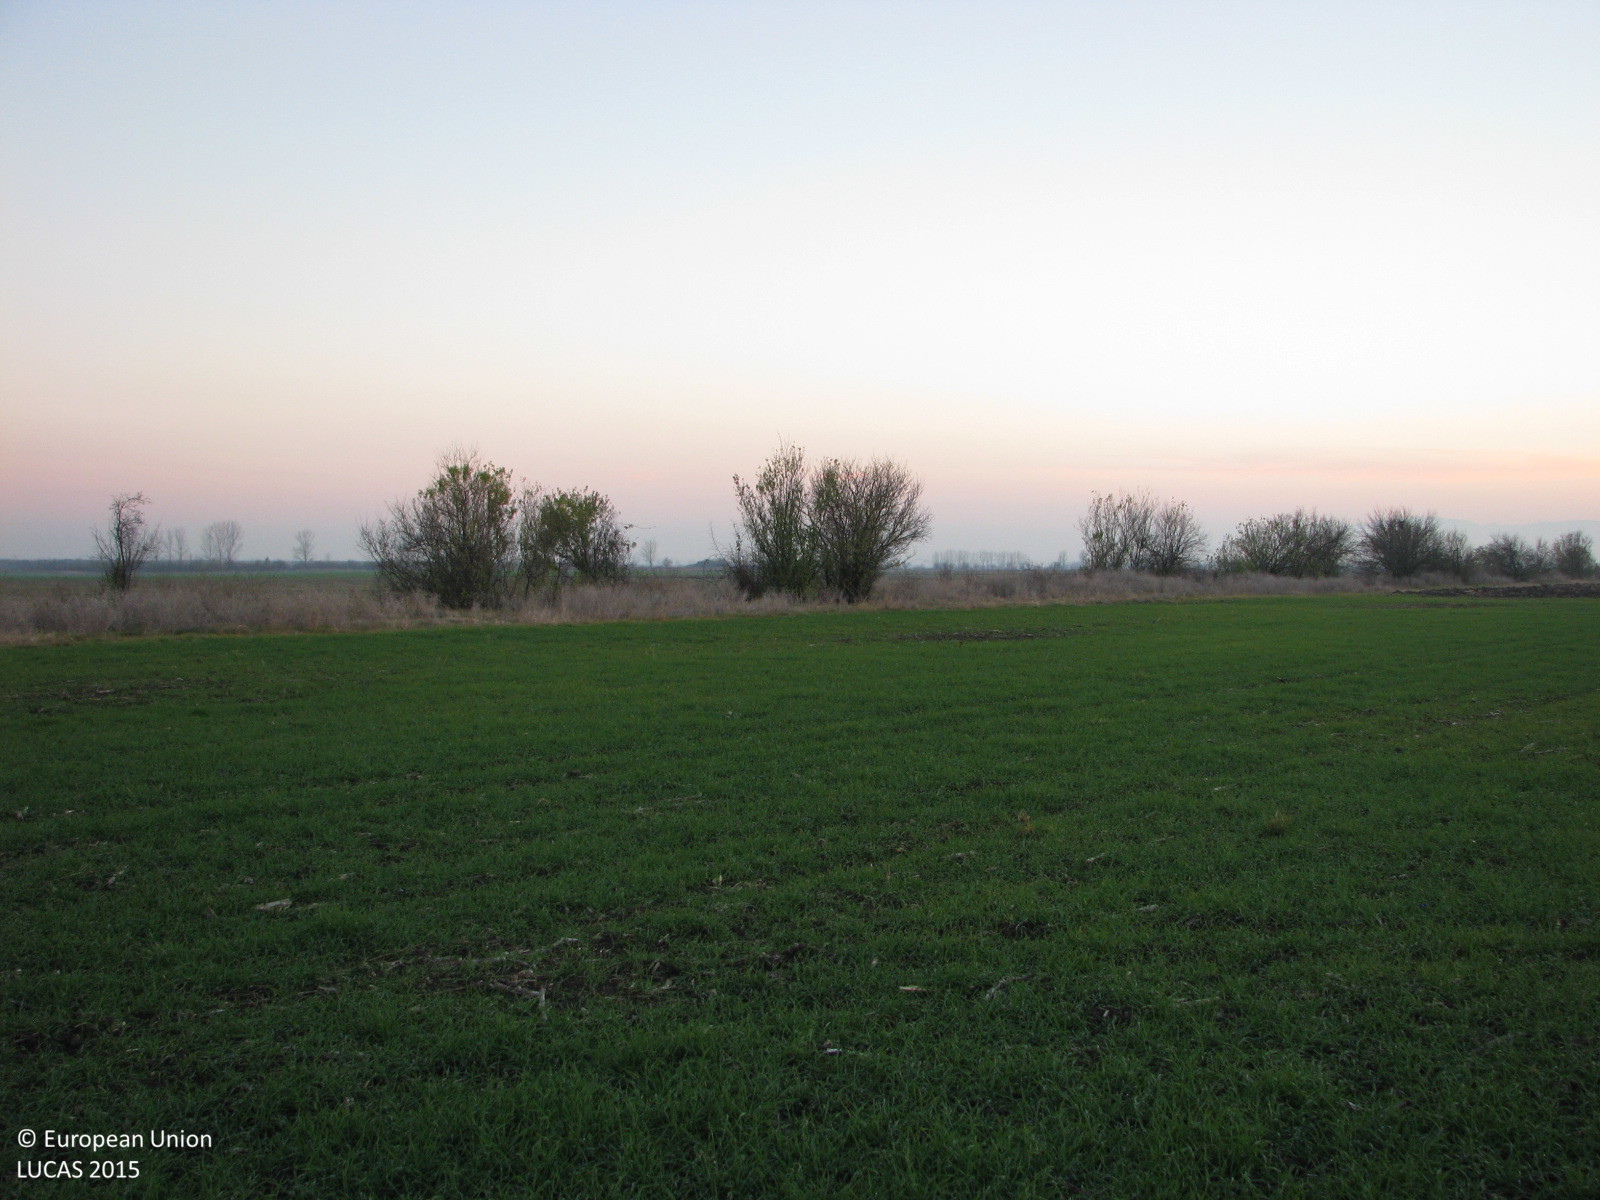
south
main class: Cropland
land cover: Common wheat
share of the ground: > 75 %
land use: Agriculture (excluding fallow land and kitchen gardens)
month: December
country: BG
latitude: 42.2978
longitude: 25.0138
